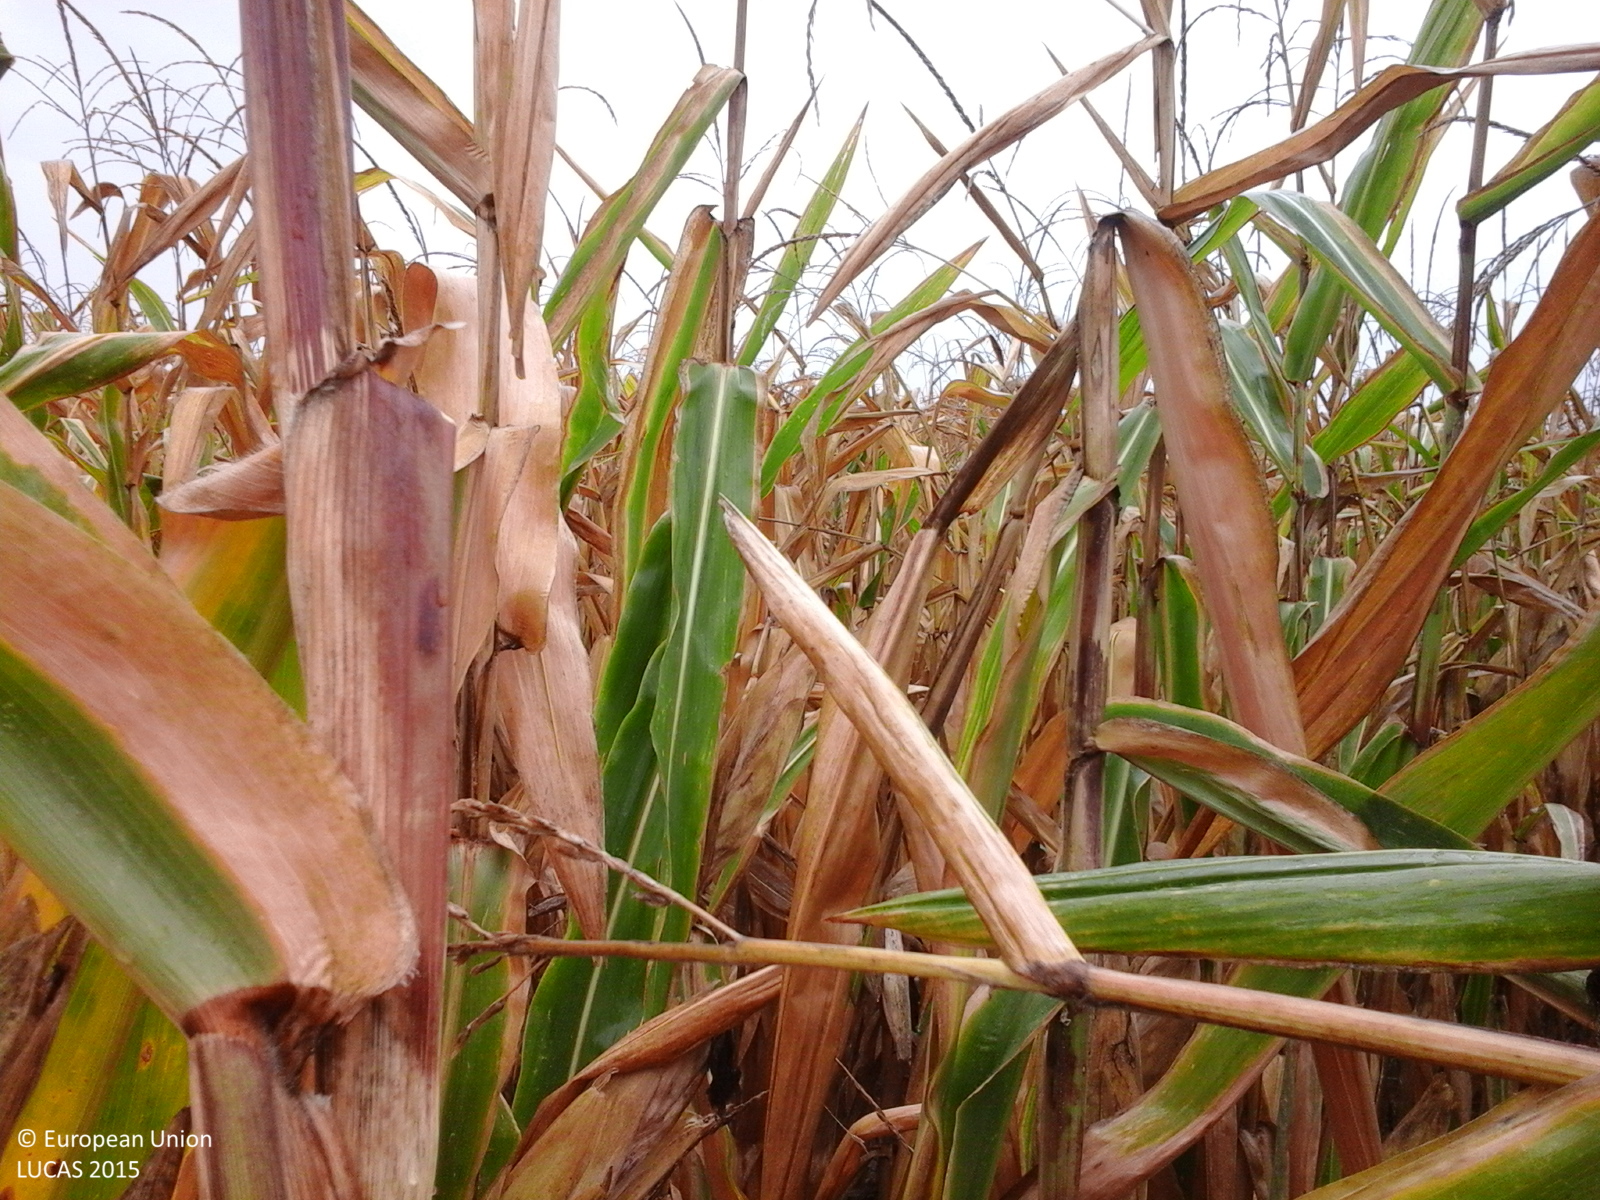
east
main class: Cropland
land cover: Maize
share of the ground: > 75 %
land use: Agriculture (excluding fallow land and kitchen gardens)
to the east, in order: Maize; Sunflower; Maize
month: September
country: RO
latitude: 47.4888
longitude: 22.1966
